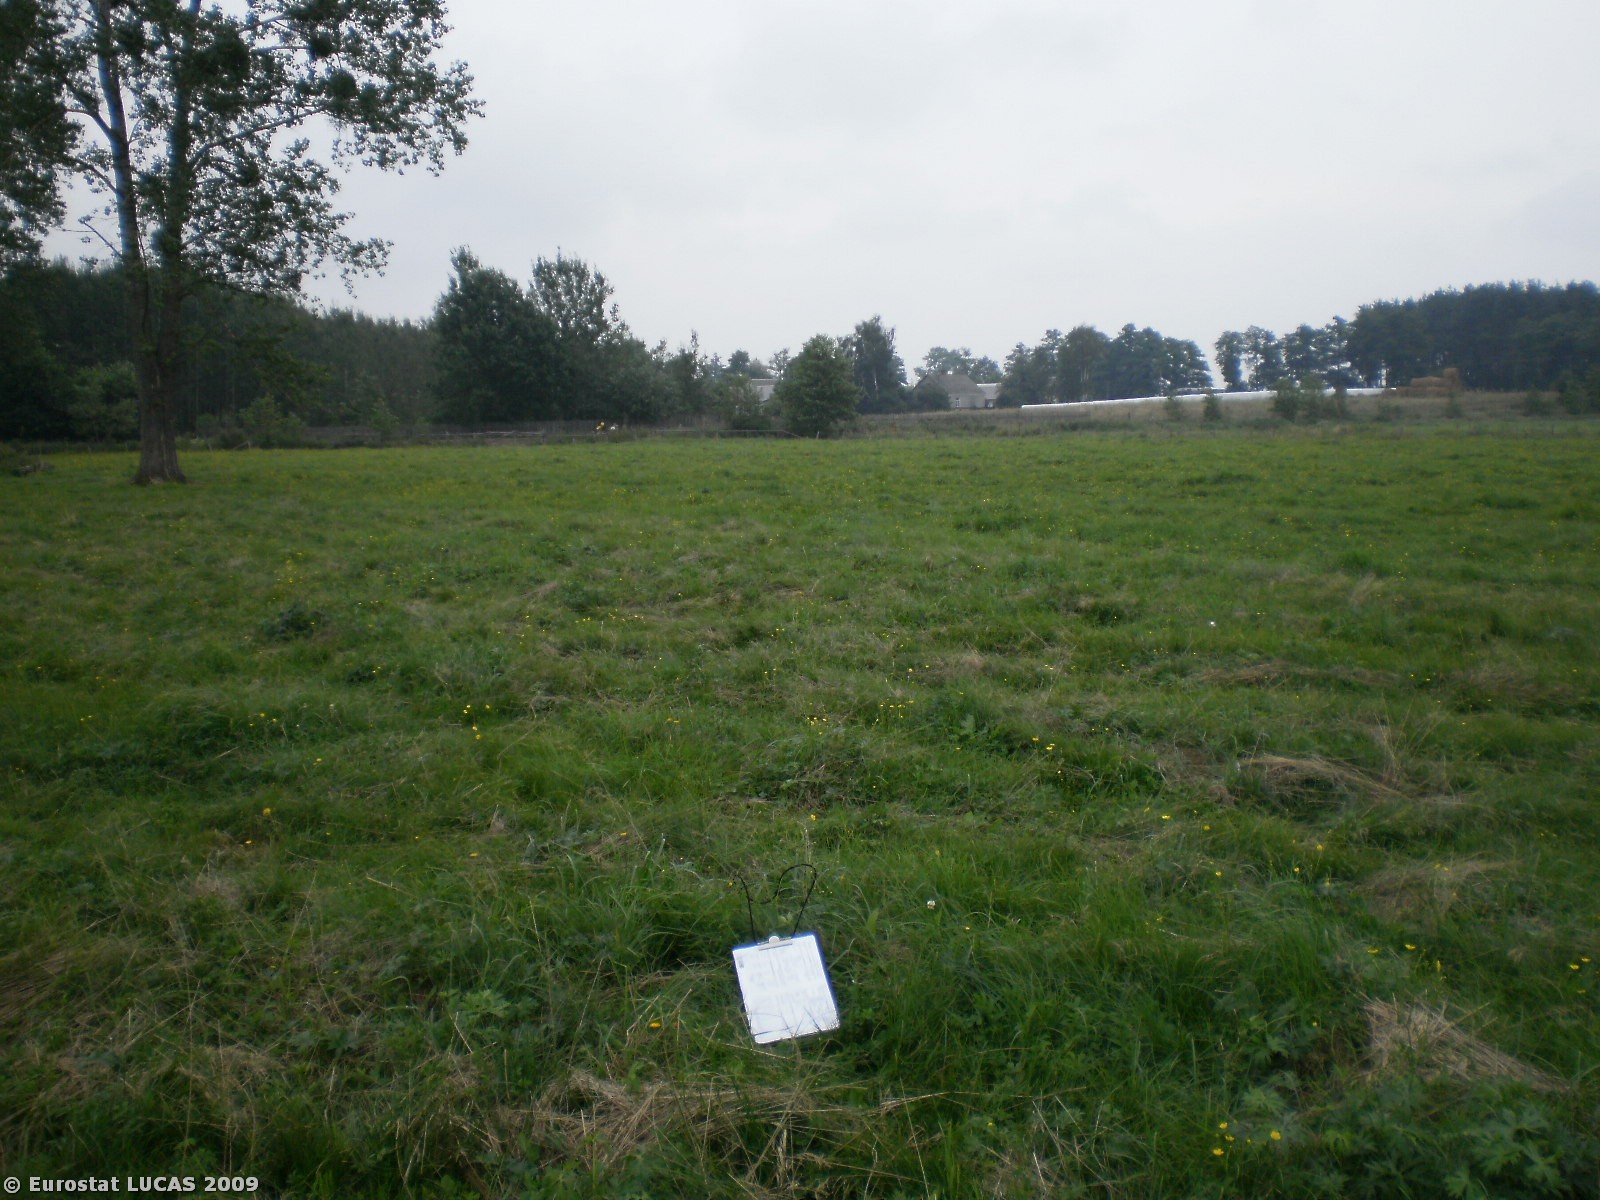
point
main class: Grassland
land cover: Grassland without tree/shrub cover
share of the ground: > 75 %
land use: Agriculture (excluding fallow land and kitchen gardens)
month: August
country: PL
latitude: 53.1474
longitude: 21.0639
